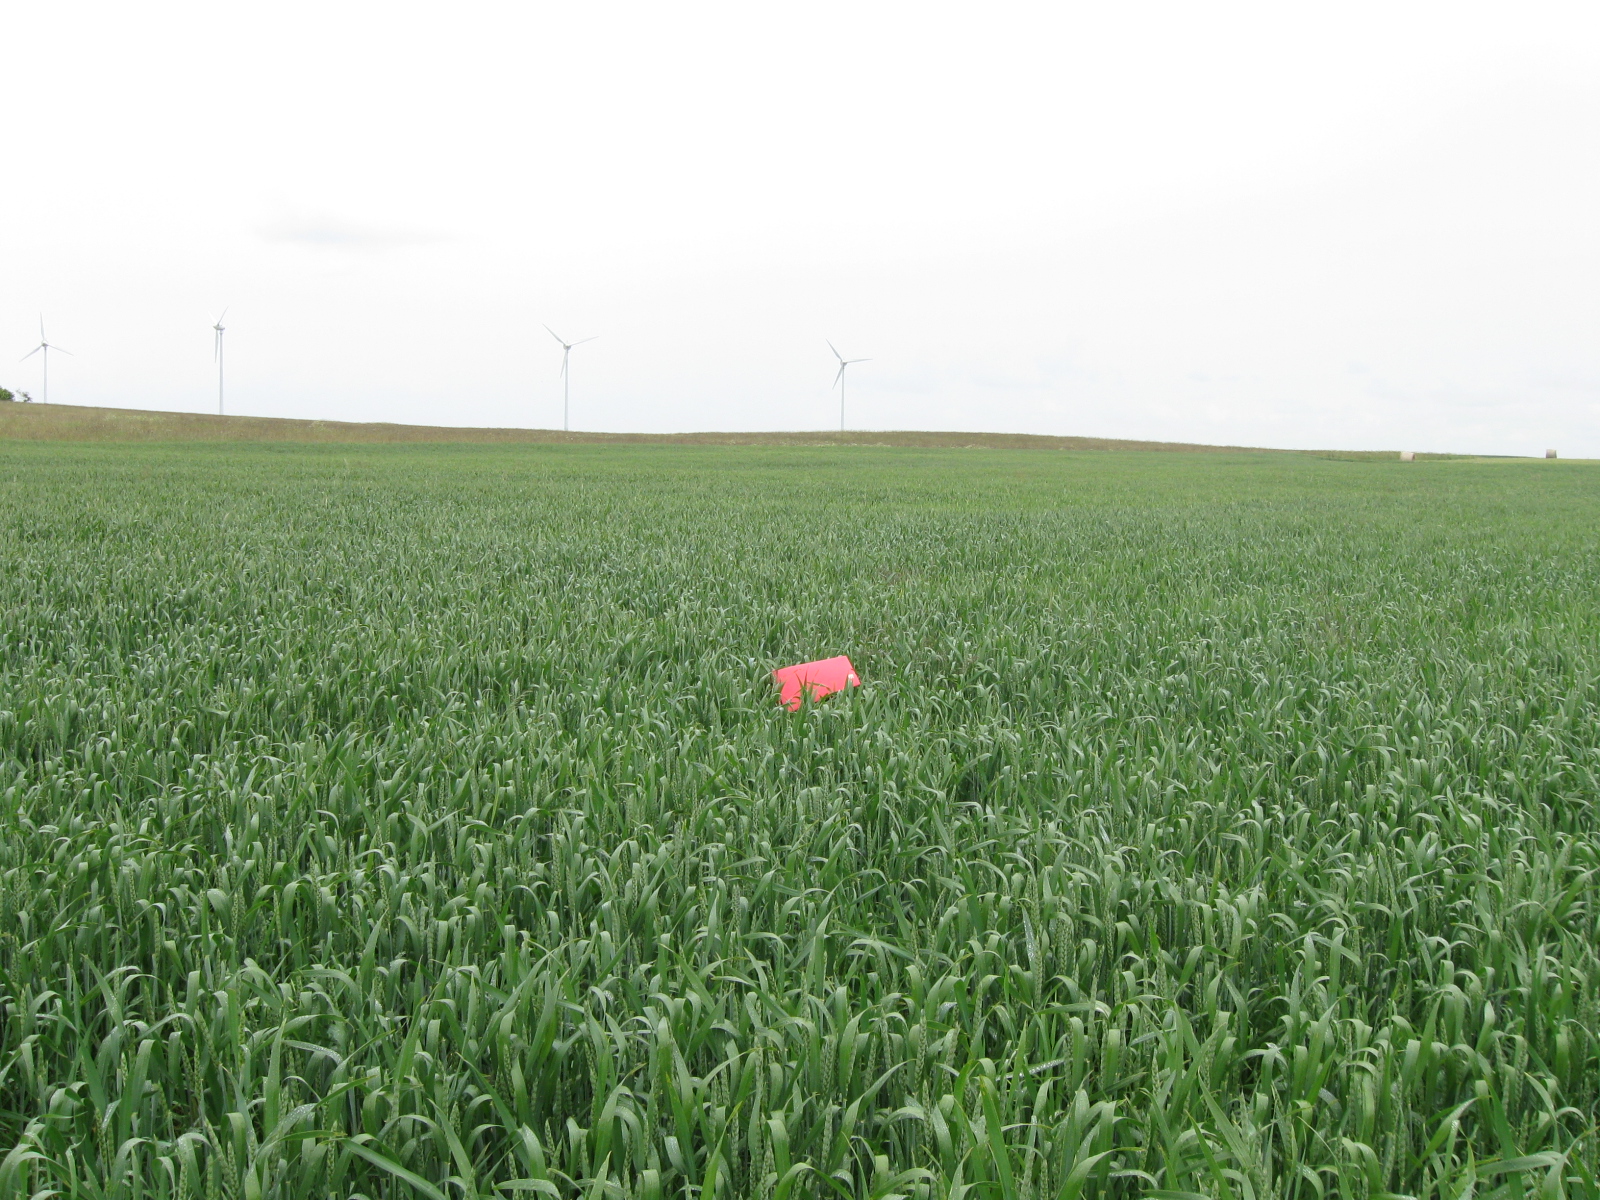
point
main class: Cropland
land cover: Common wheat
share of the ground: > 75 %
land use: Agriculture (excluding fallow land and kitchen gardens)
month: June
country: LT
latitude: 54.9113
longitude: 24.5633
